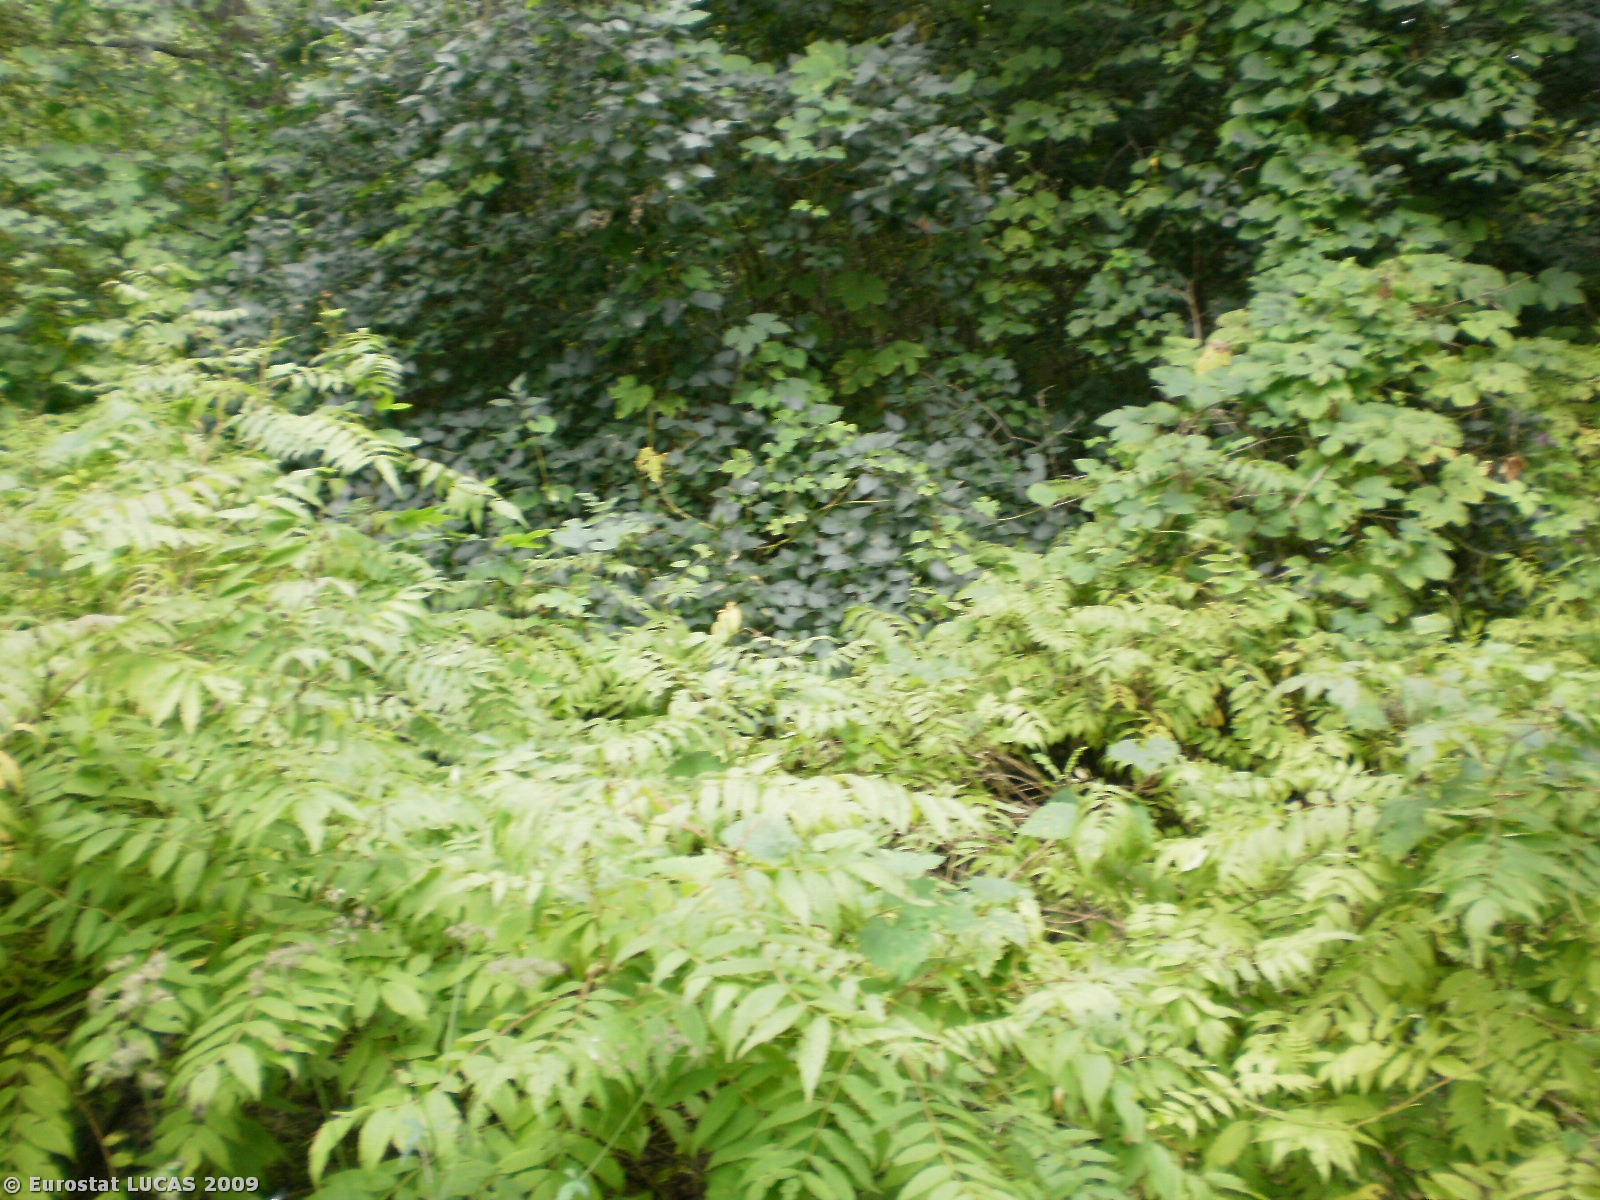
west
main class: Woodland
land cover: Broadleaved woodland
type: mire and swamp forests
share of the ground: > 75 %
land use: Forestry
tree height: > 5 m
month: August
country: PL
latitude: 53.5693
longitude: 21.9709
